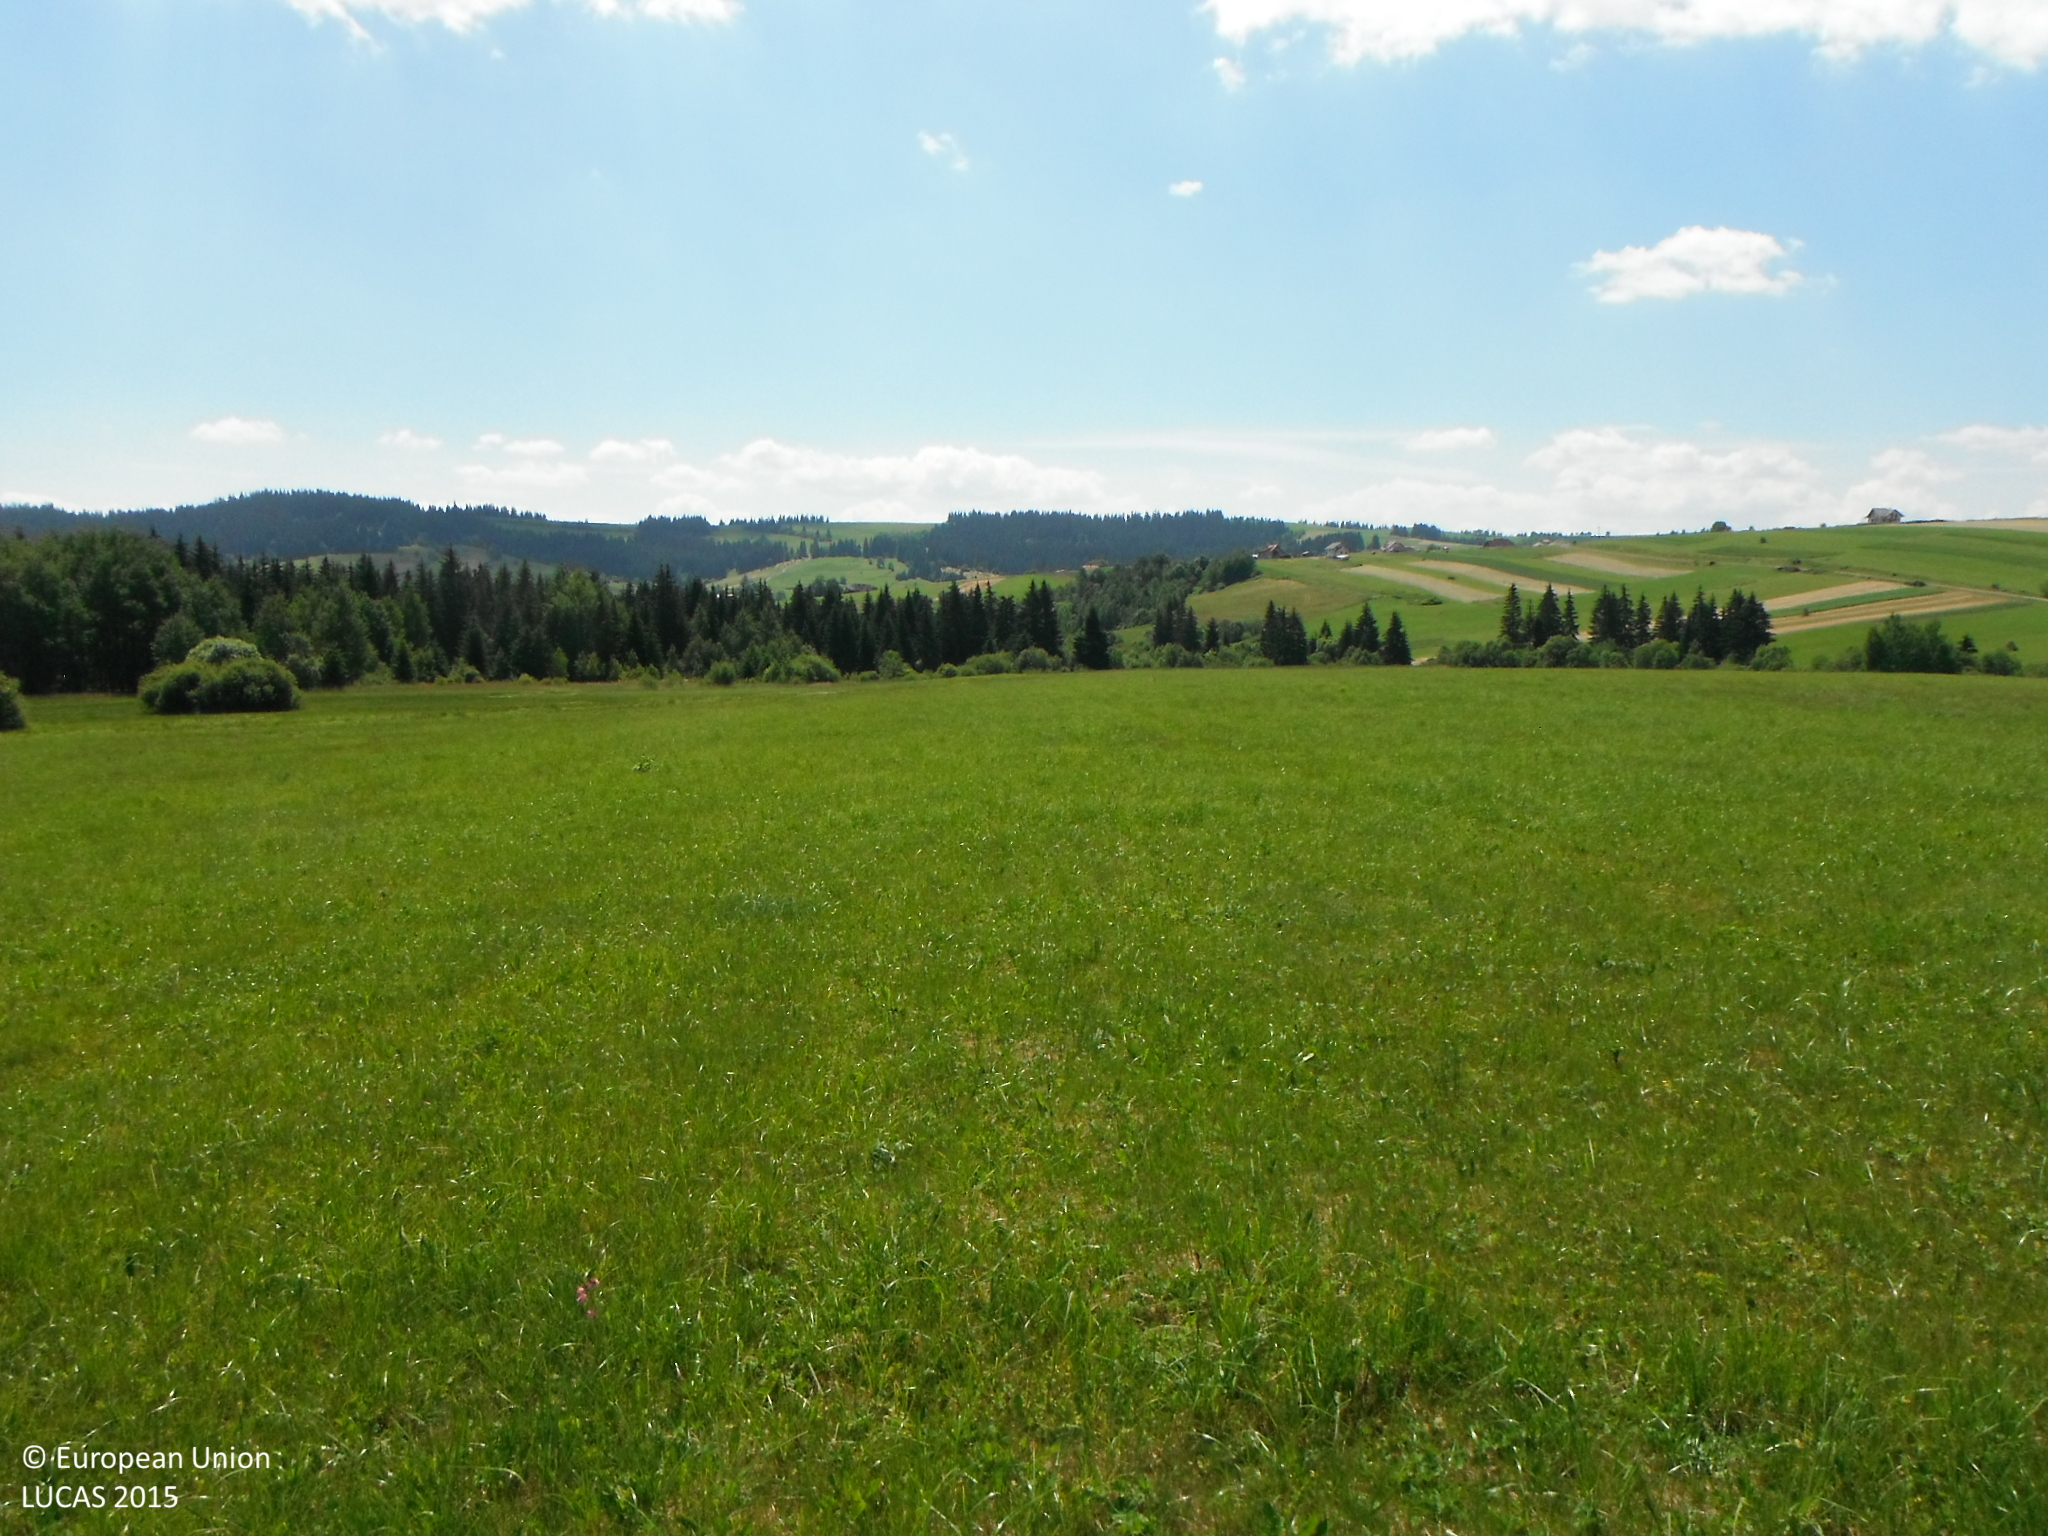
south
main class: Grassland
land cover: Grassland without tree/shrub cover
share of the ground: > 75 %
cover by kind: herbaceous plants 100 %
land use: Agriculture (excluding fallow land and kitchen gardens)
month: July
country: SK
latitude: 49.4742
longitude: 19.3407
